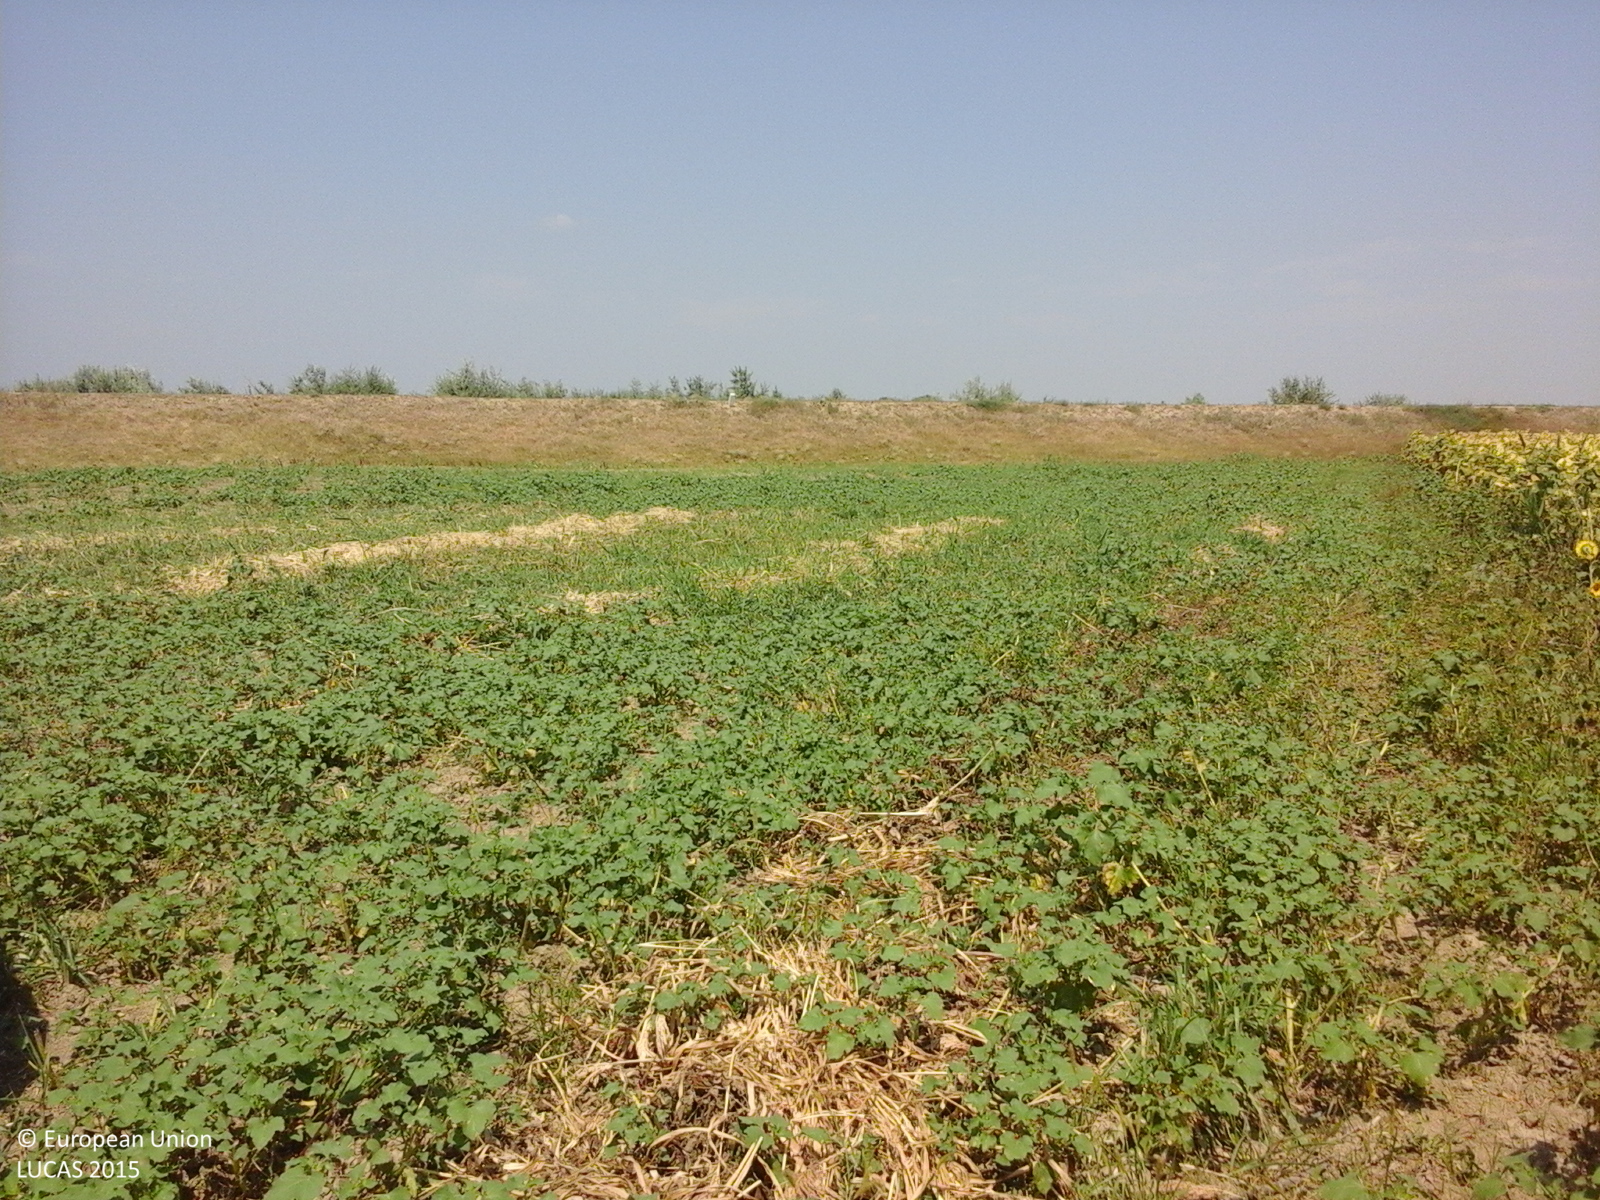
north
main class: Grassland
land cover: Spontaneously vegetated surfaces
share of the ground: > 75 %
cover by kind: herbaceous plants 100 %
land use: Agriculture (excluding fallow land and kitchen gardens)
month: August
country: RO
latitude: 45.1482
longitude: 27.3017
